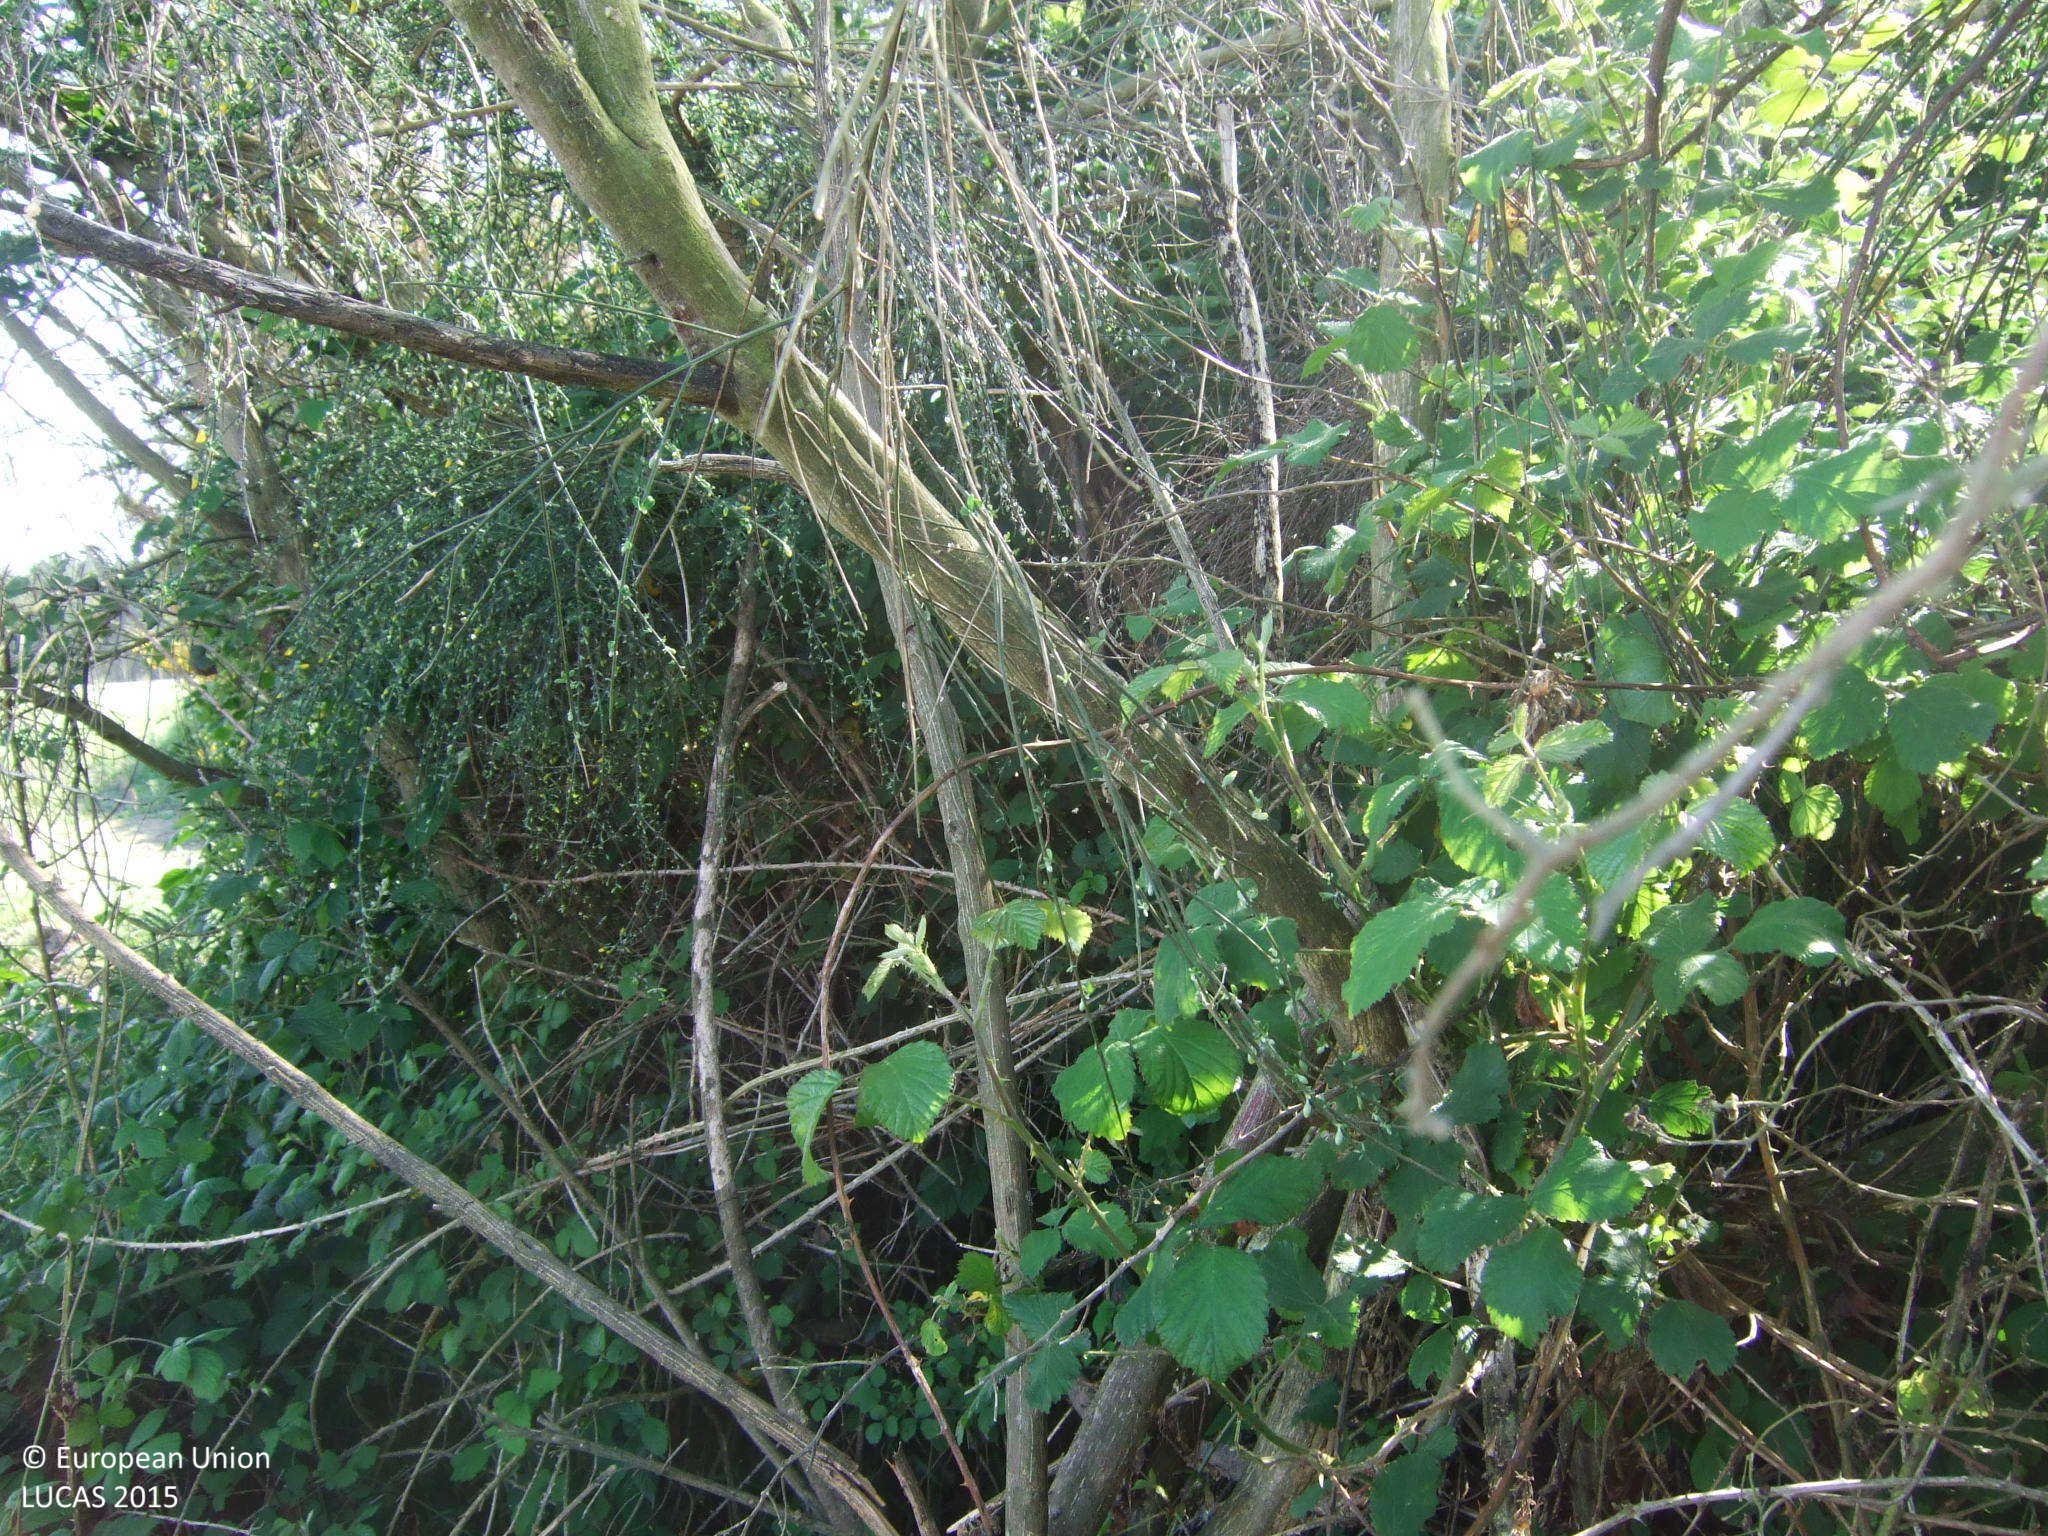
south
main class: Shrubland
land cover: Shrubland with sparse tree cover
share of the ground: > 75 %
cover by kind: shrubs 95 %, broadleaved forest trees 5 %
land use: Abandoned areas
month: May
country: ES
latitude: 43.0865
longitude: -7.4067
